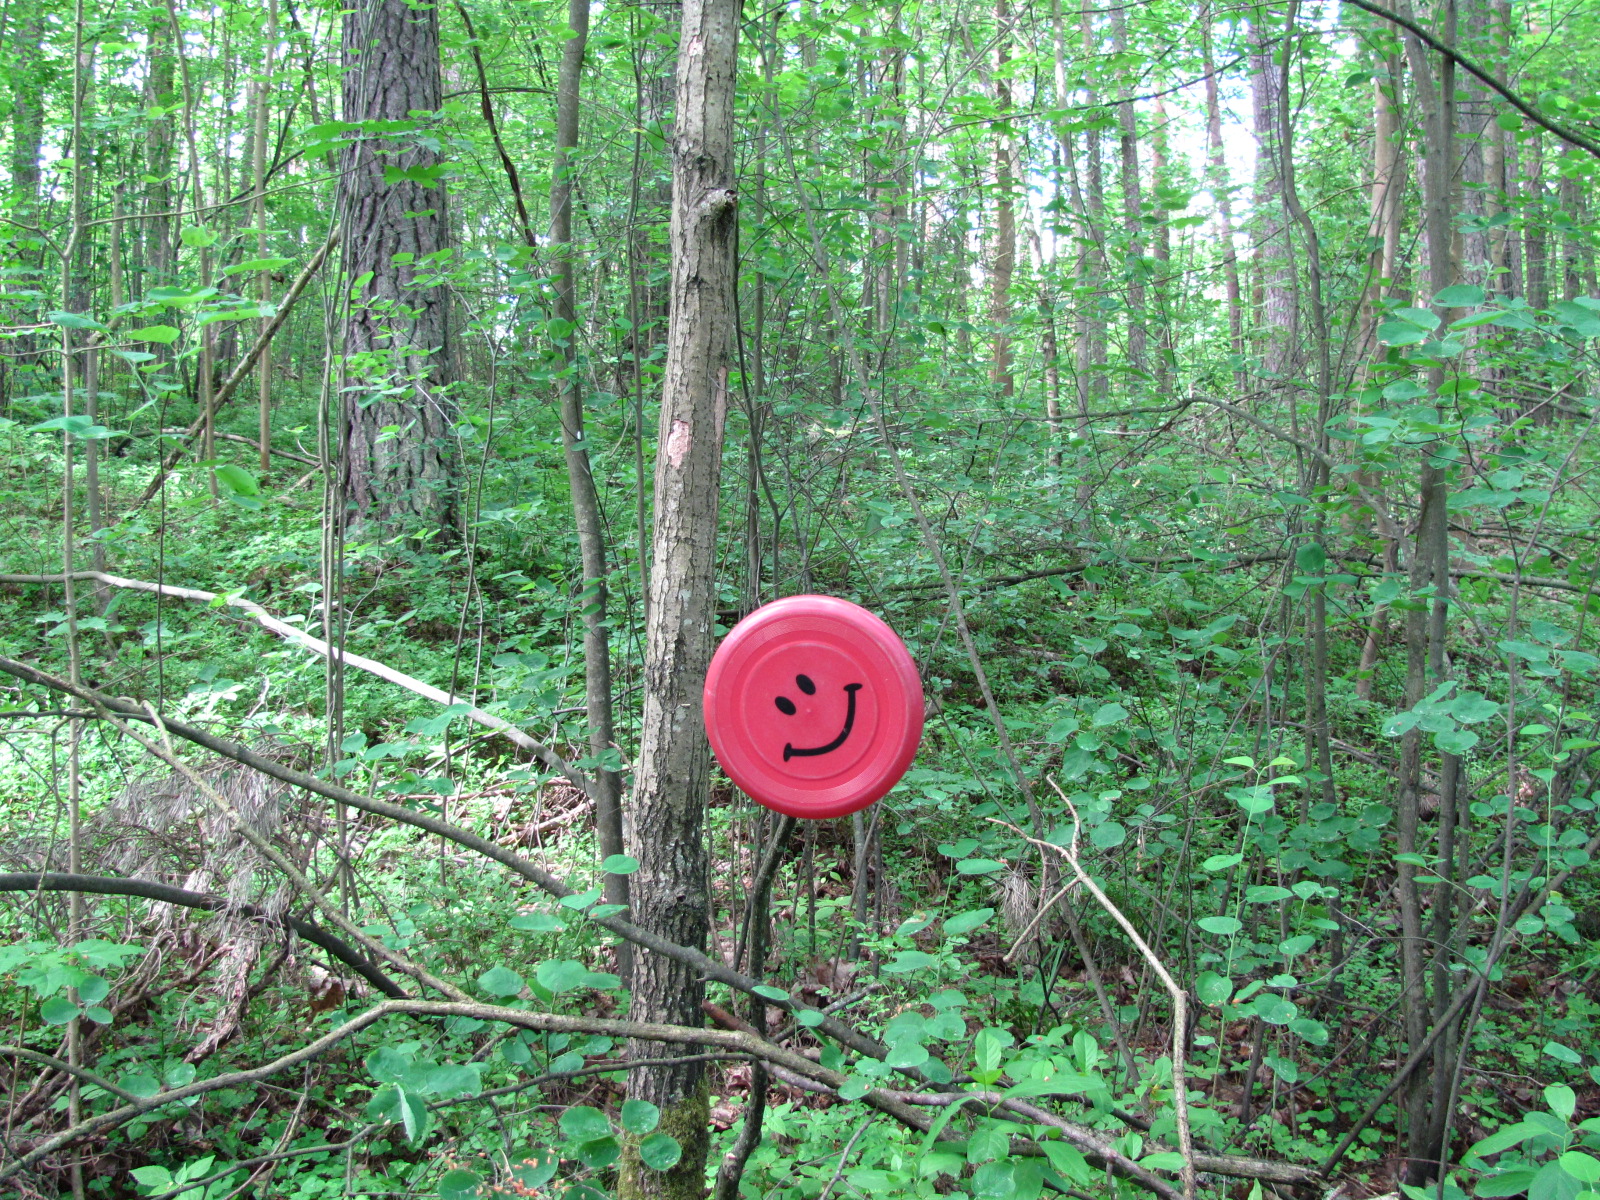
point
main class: Woodland
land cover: Pine dominated mixed woodland
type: hemiboreal forest and nemoral coniferous forest and mixed broadleaved-coniferous forest
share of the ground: > 75 %
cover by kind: broadleaved forest trees 60 %, coniferous forest trees 40 %
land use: Forestry
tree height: > 5 m
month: June
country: LV
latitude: 56.9853
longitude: 24.0217
